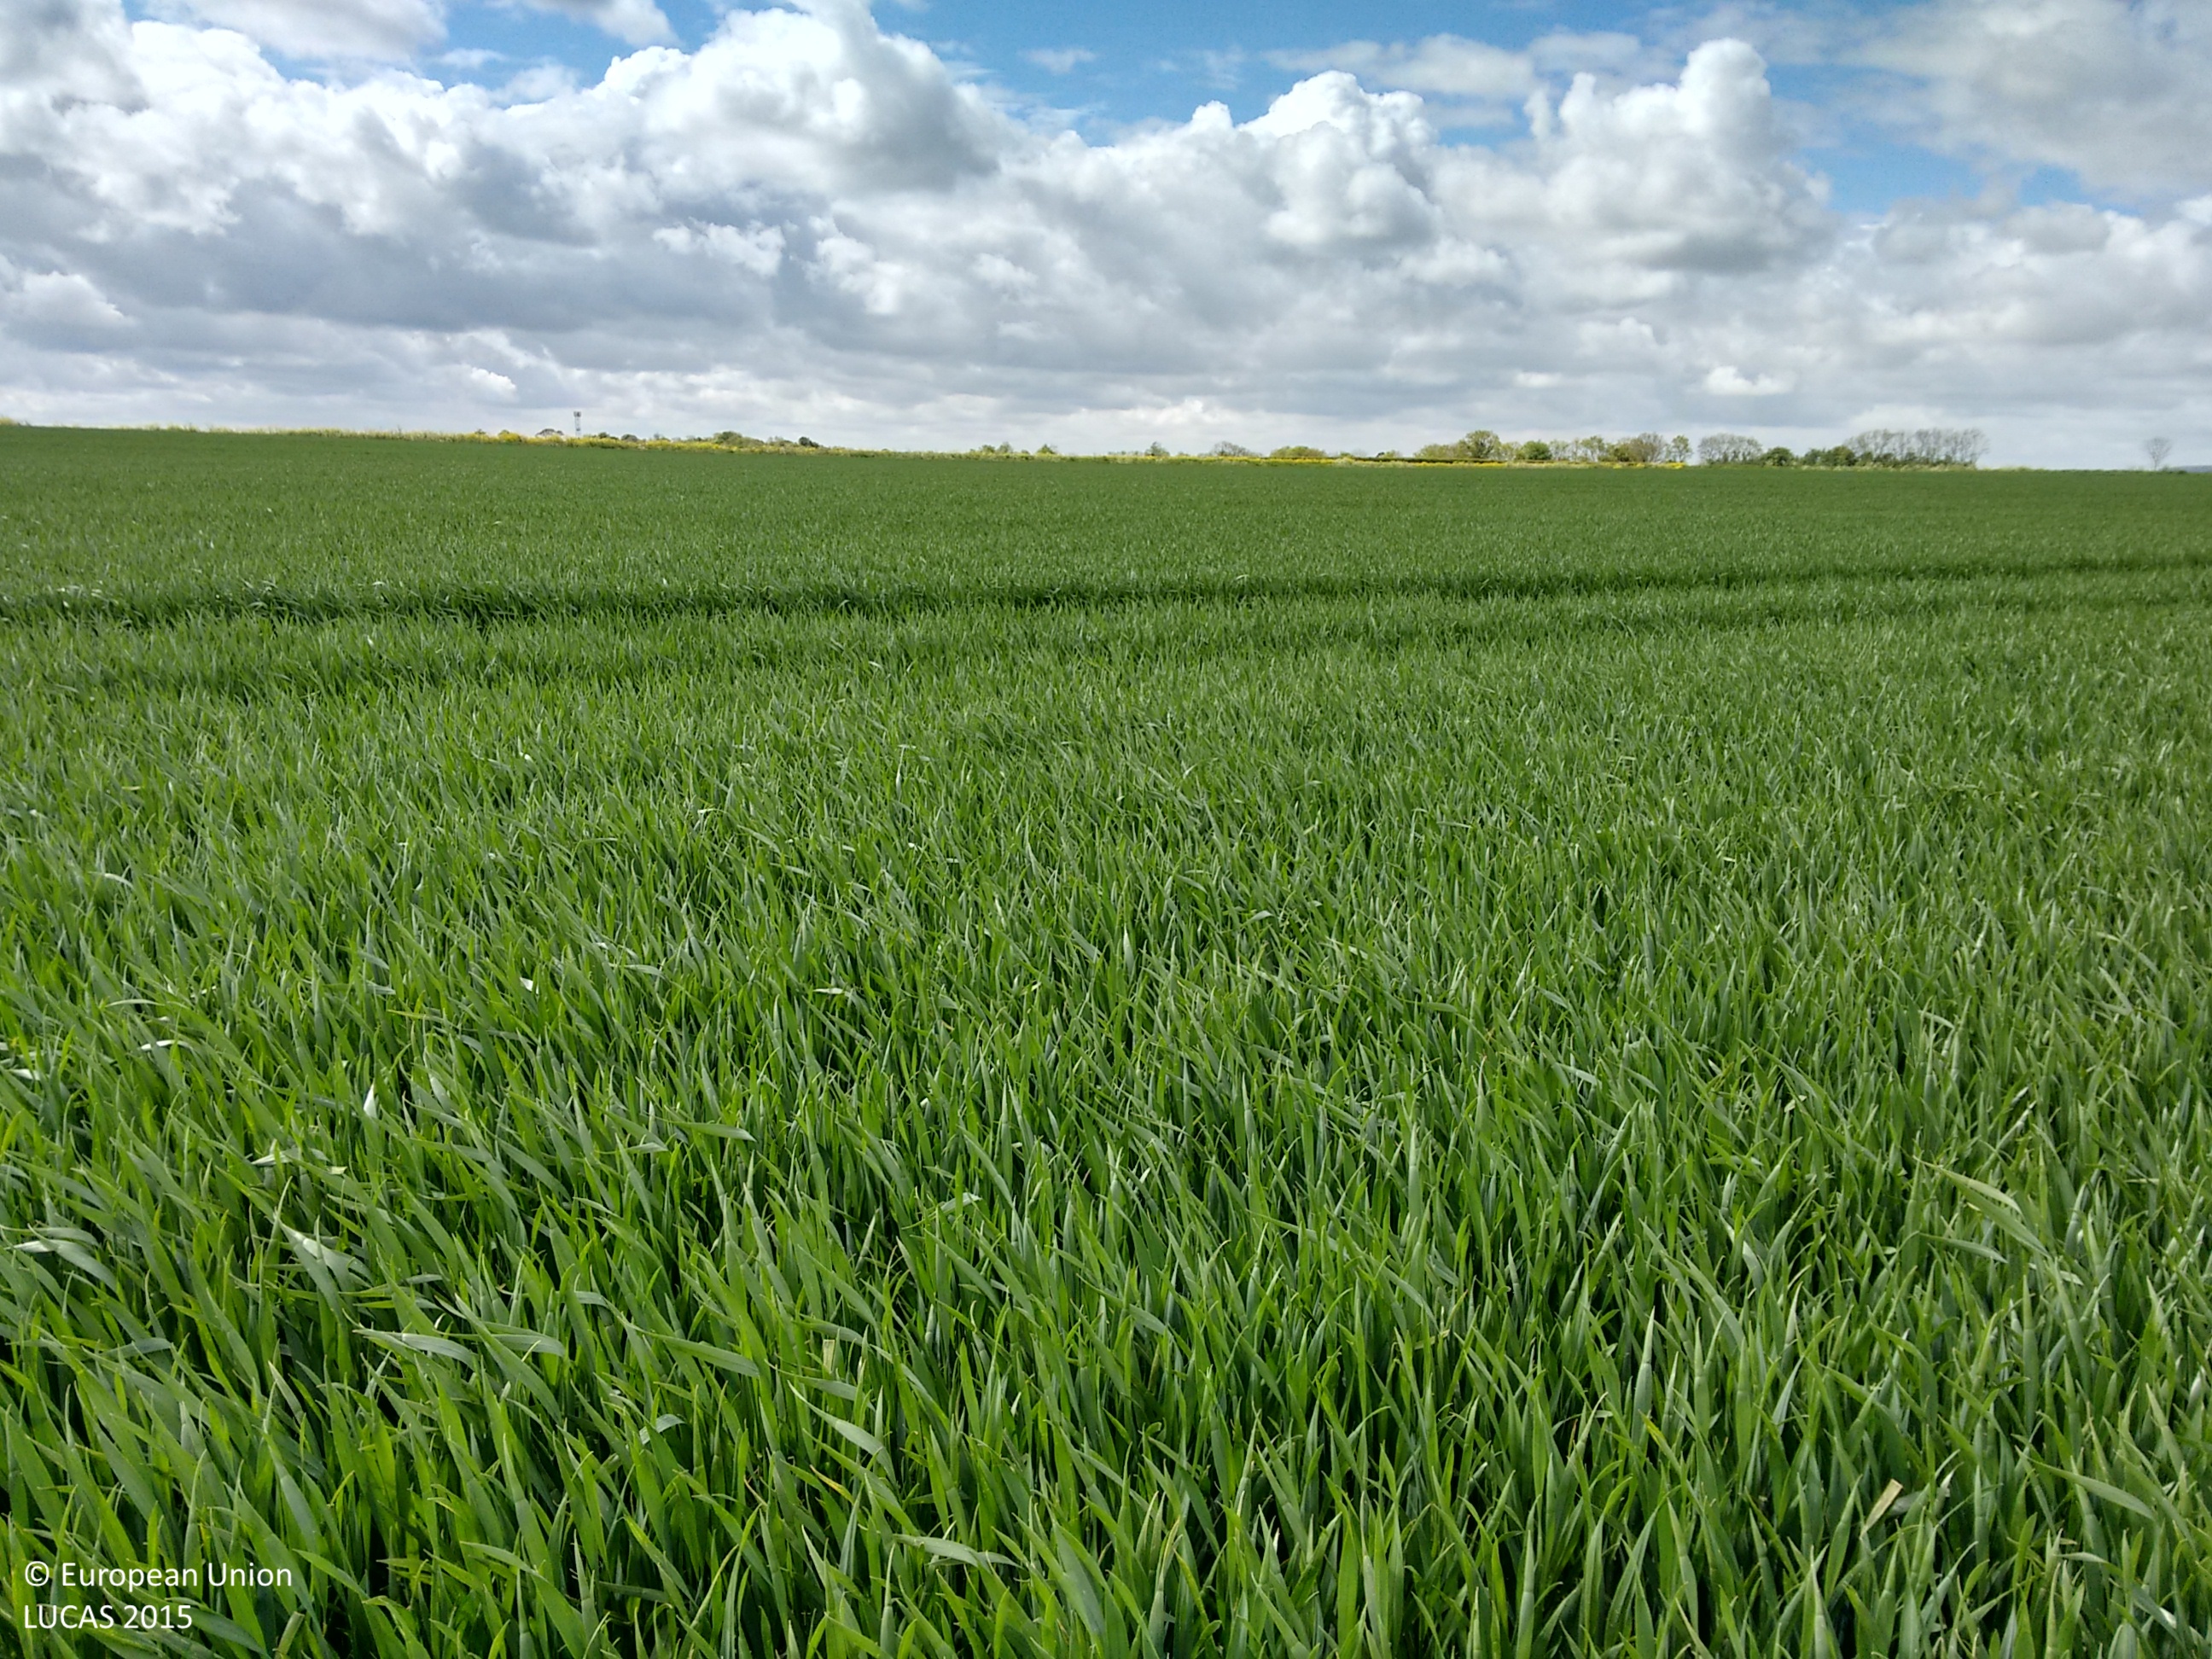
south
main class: Cropland
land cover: Common wheat
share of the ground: > 75 %
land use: Agriculture (excluding fallow land and kitchen gardens)
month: May
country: GB
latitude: 53.5101
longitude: -0.0294
